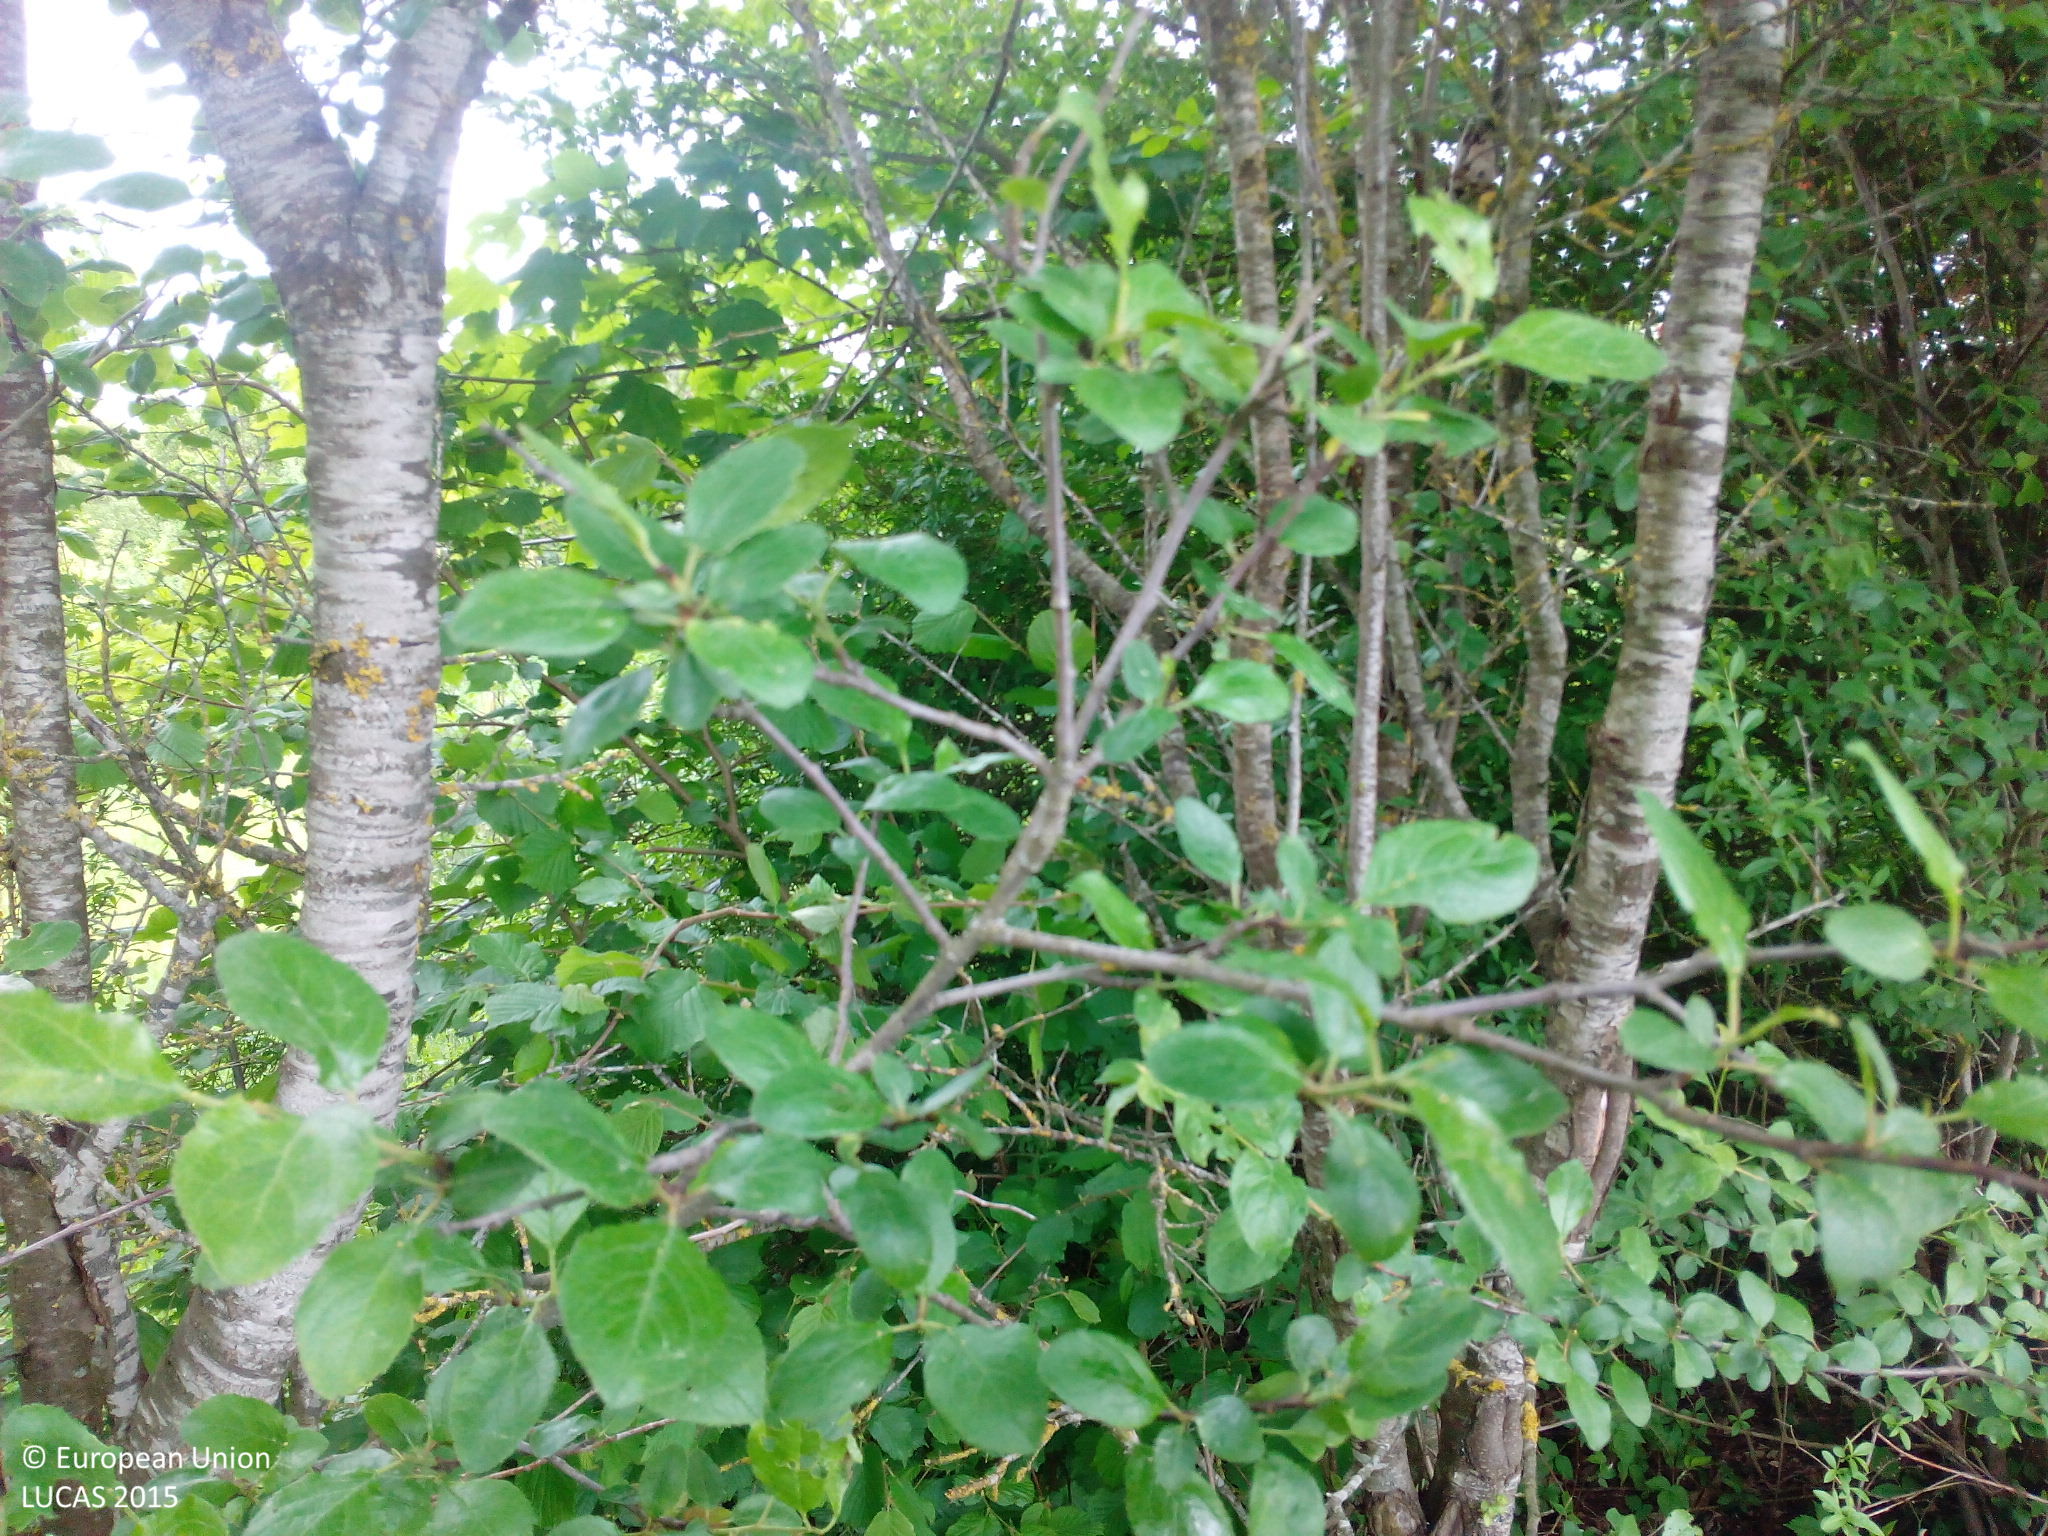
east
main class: Grassland
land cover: Grassland with sparse tree/shrub cover
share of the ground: > 75 %
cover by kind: herbaceous plants 95 %, broadleaved forest trees 5 %
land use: Residential
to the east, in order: Abandoned hedges; Grassland with sparse tree/shrub cover; Artificial constructions in urban areas; Grassland without tree/shrub cover; Tracks; Grassland without tree/shrub cover
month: May
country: DE
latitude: 48.1155
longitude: 9.9329
